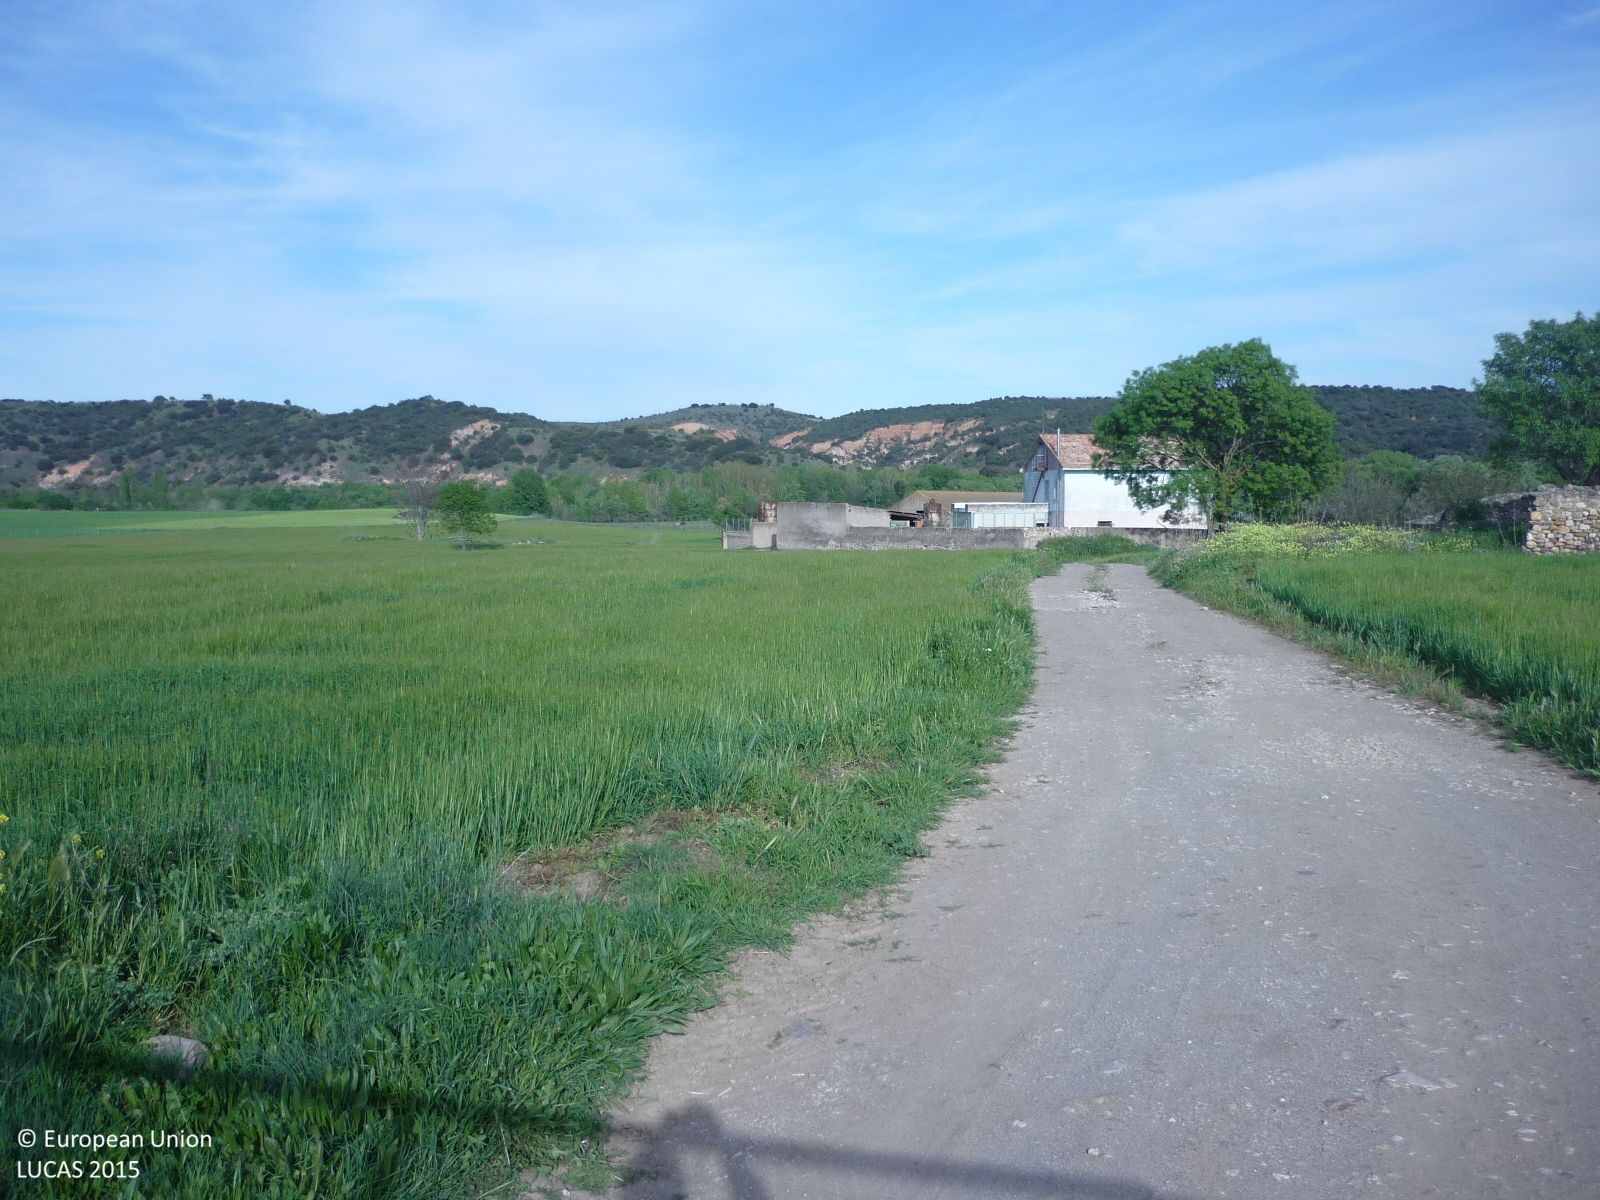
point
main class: Cropland
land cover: Barley
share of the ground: > 75 %
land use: Agriculture (excluding fallow land and kitchen gardens)
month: April
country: ES
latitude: 40.8133
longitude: -3.4953
